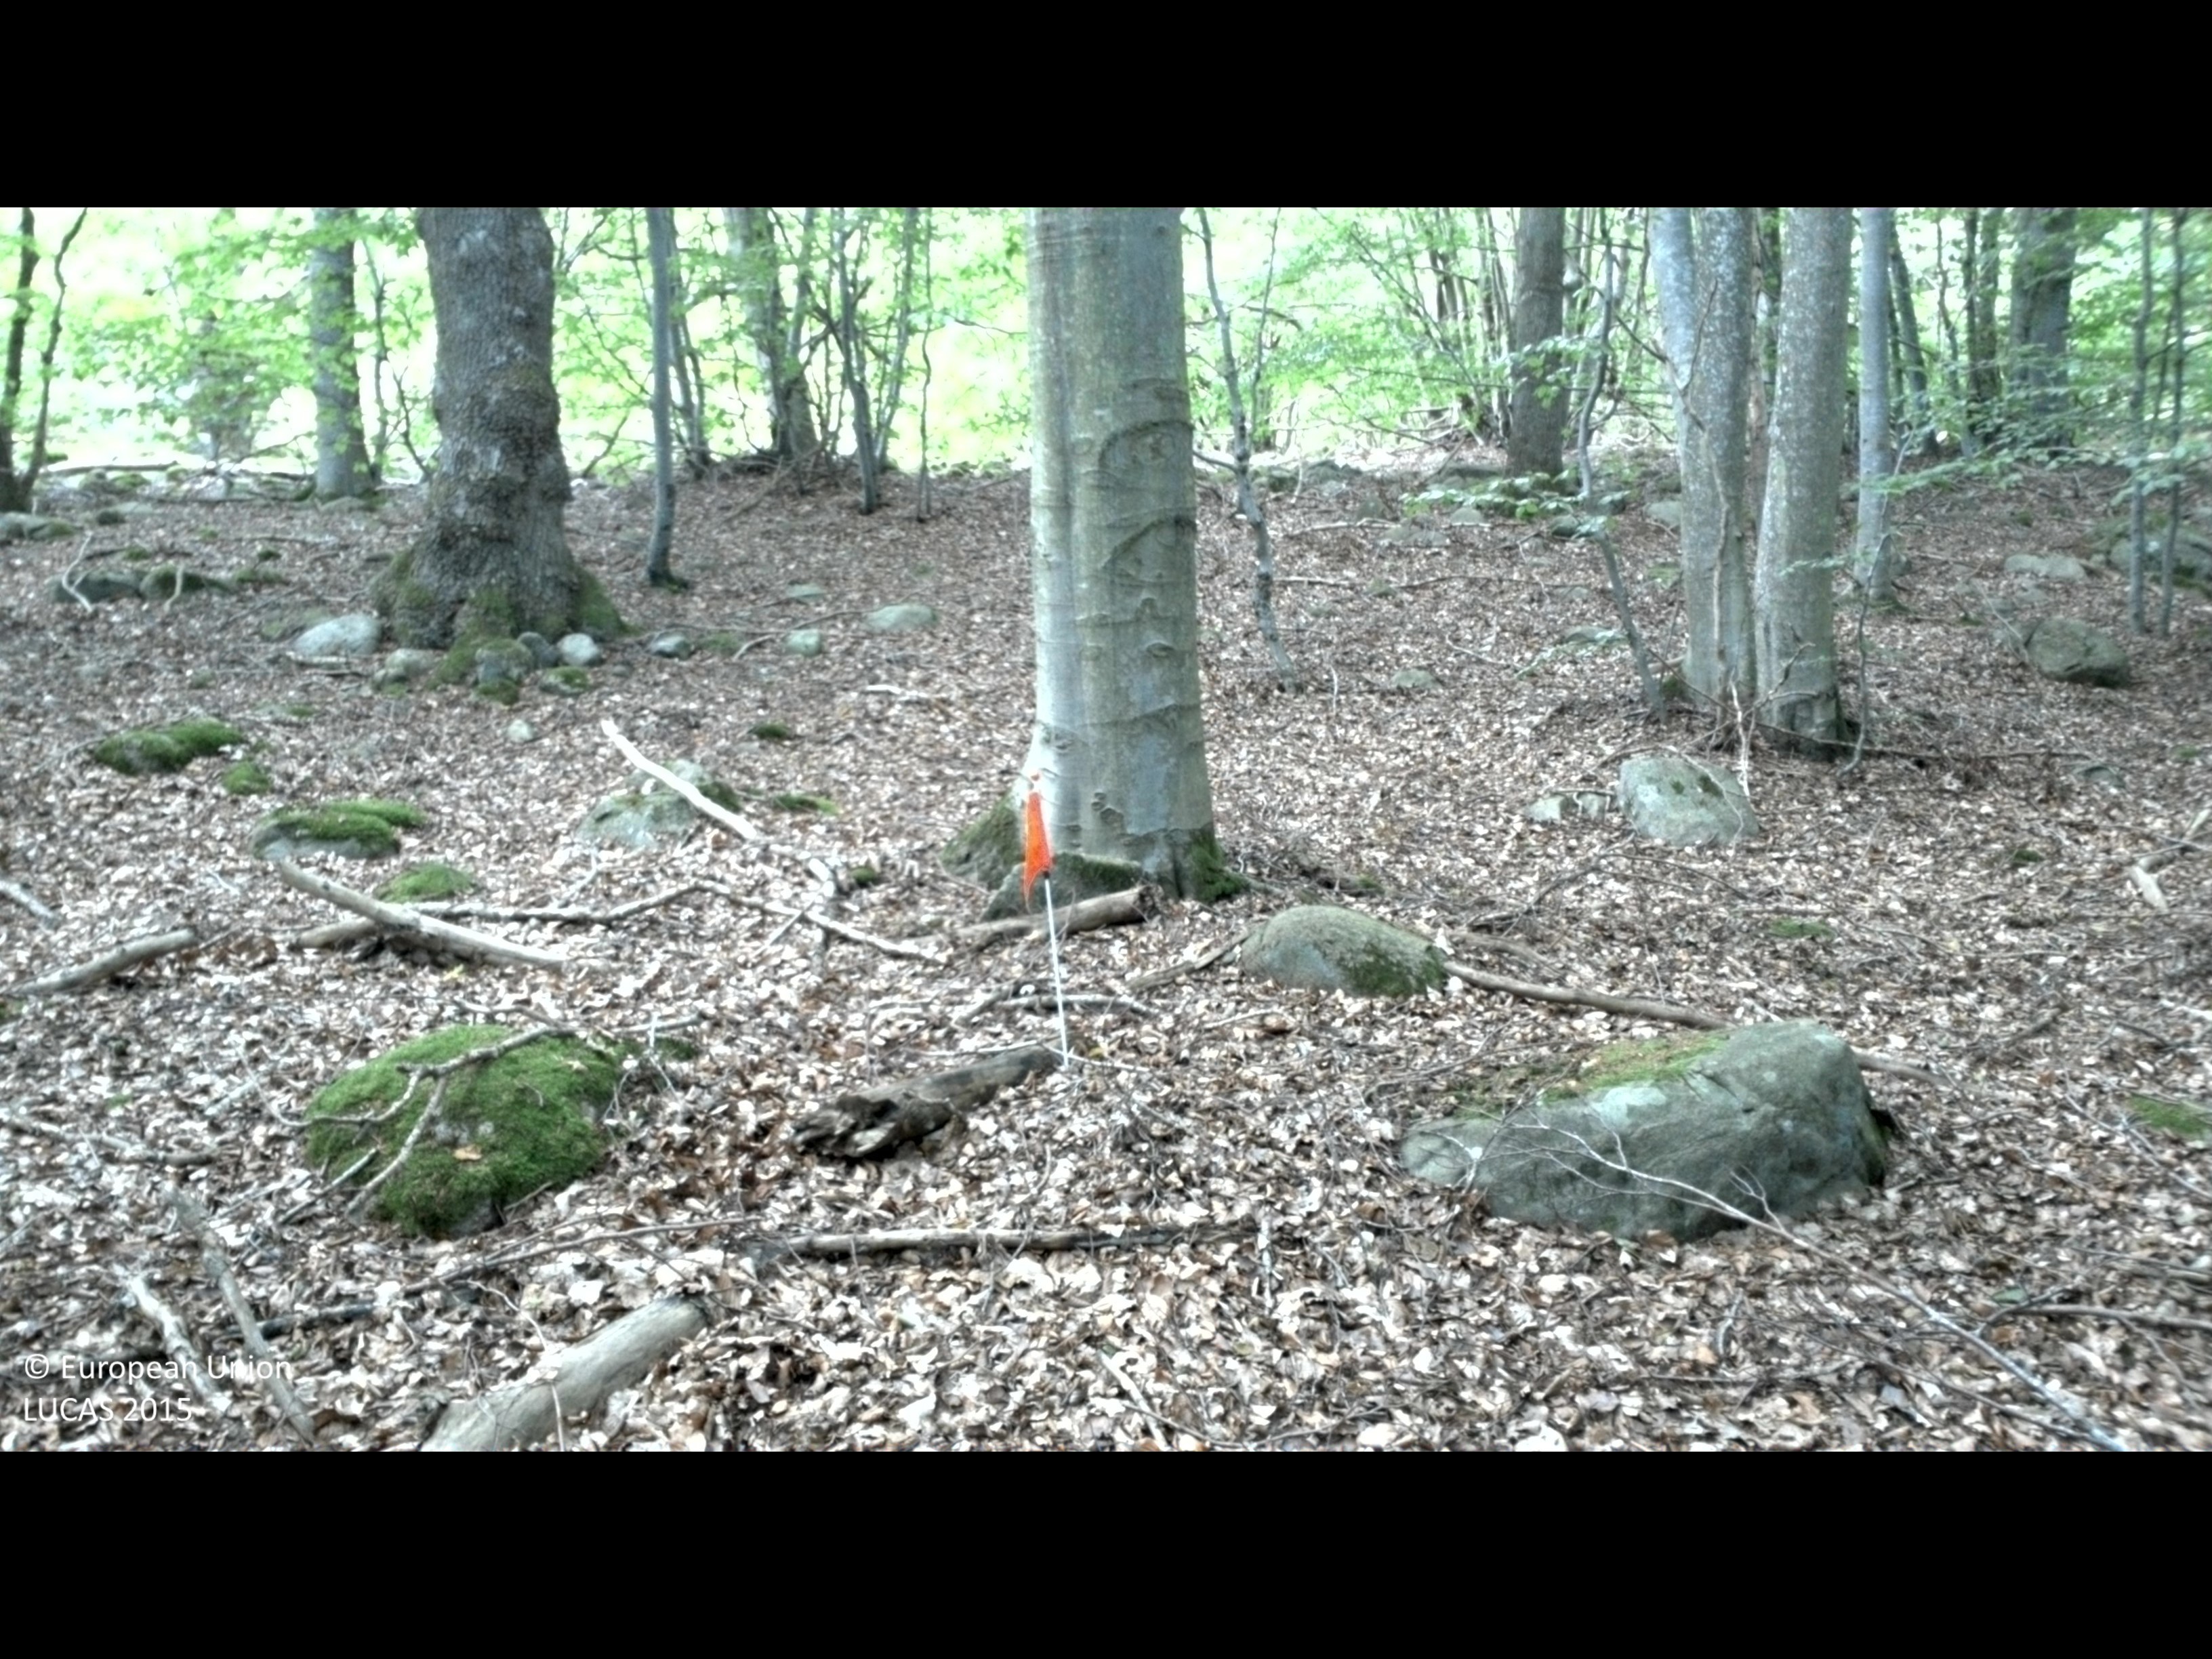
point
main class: Woodland
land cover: Broadleaved woodland
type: beech forest
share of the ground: > 75 %
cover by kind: broadleaved forest trees 75 %, consolidated bare surface 5 %
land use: Amenities, museums, leisure
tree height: > 5 m
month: September
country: SE
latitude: 56.0273
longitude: 14.7643
